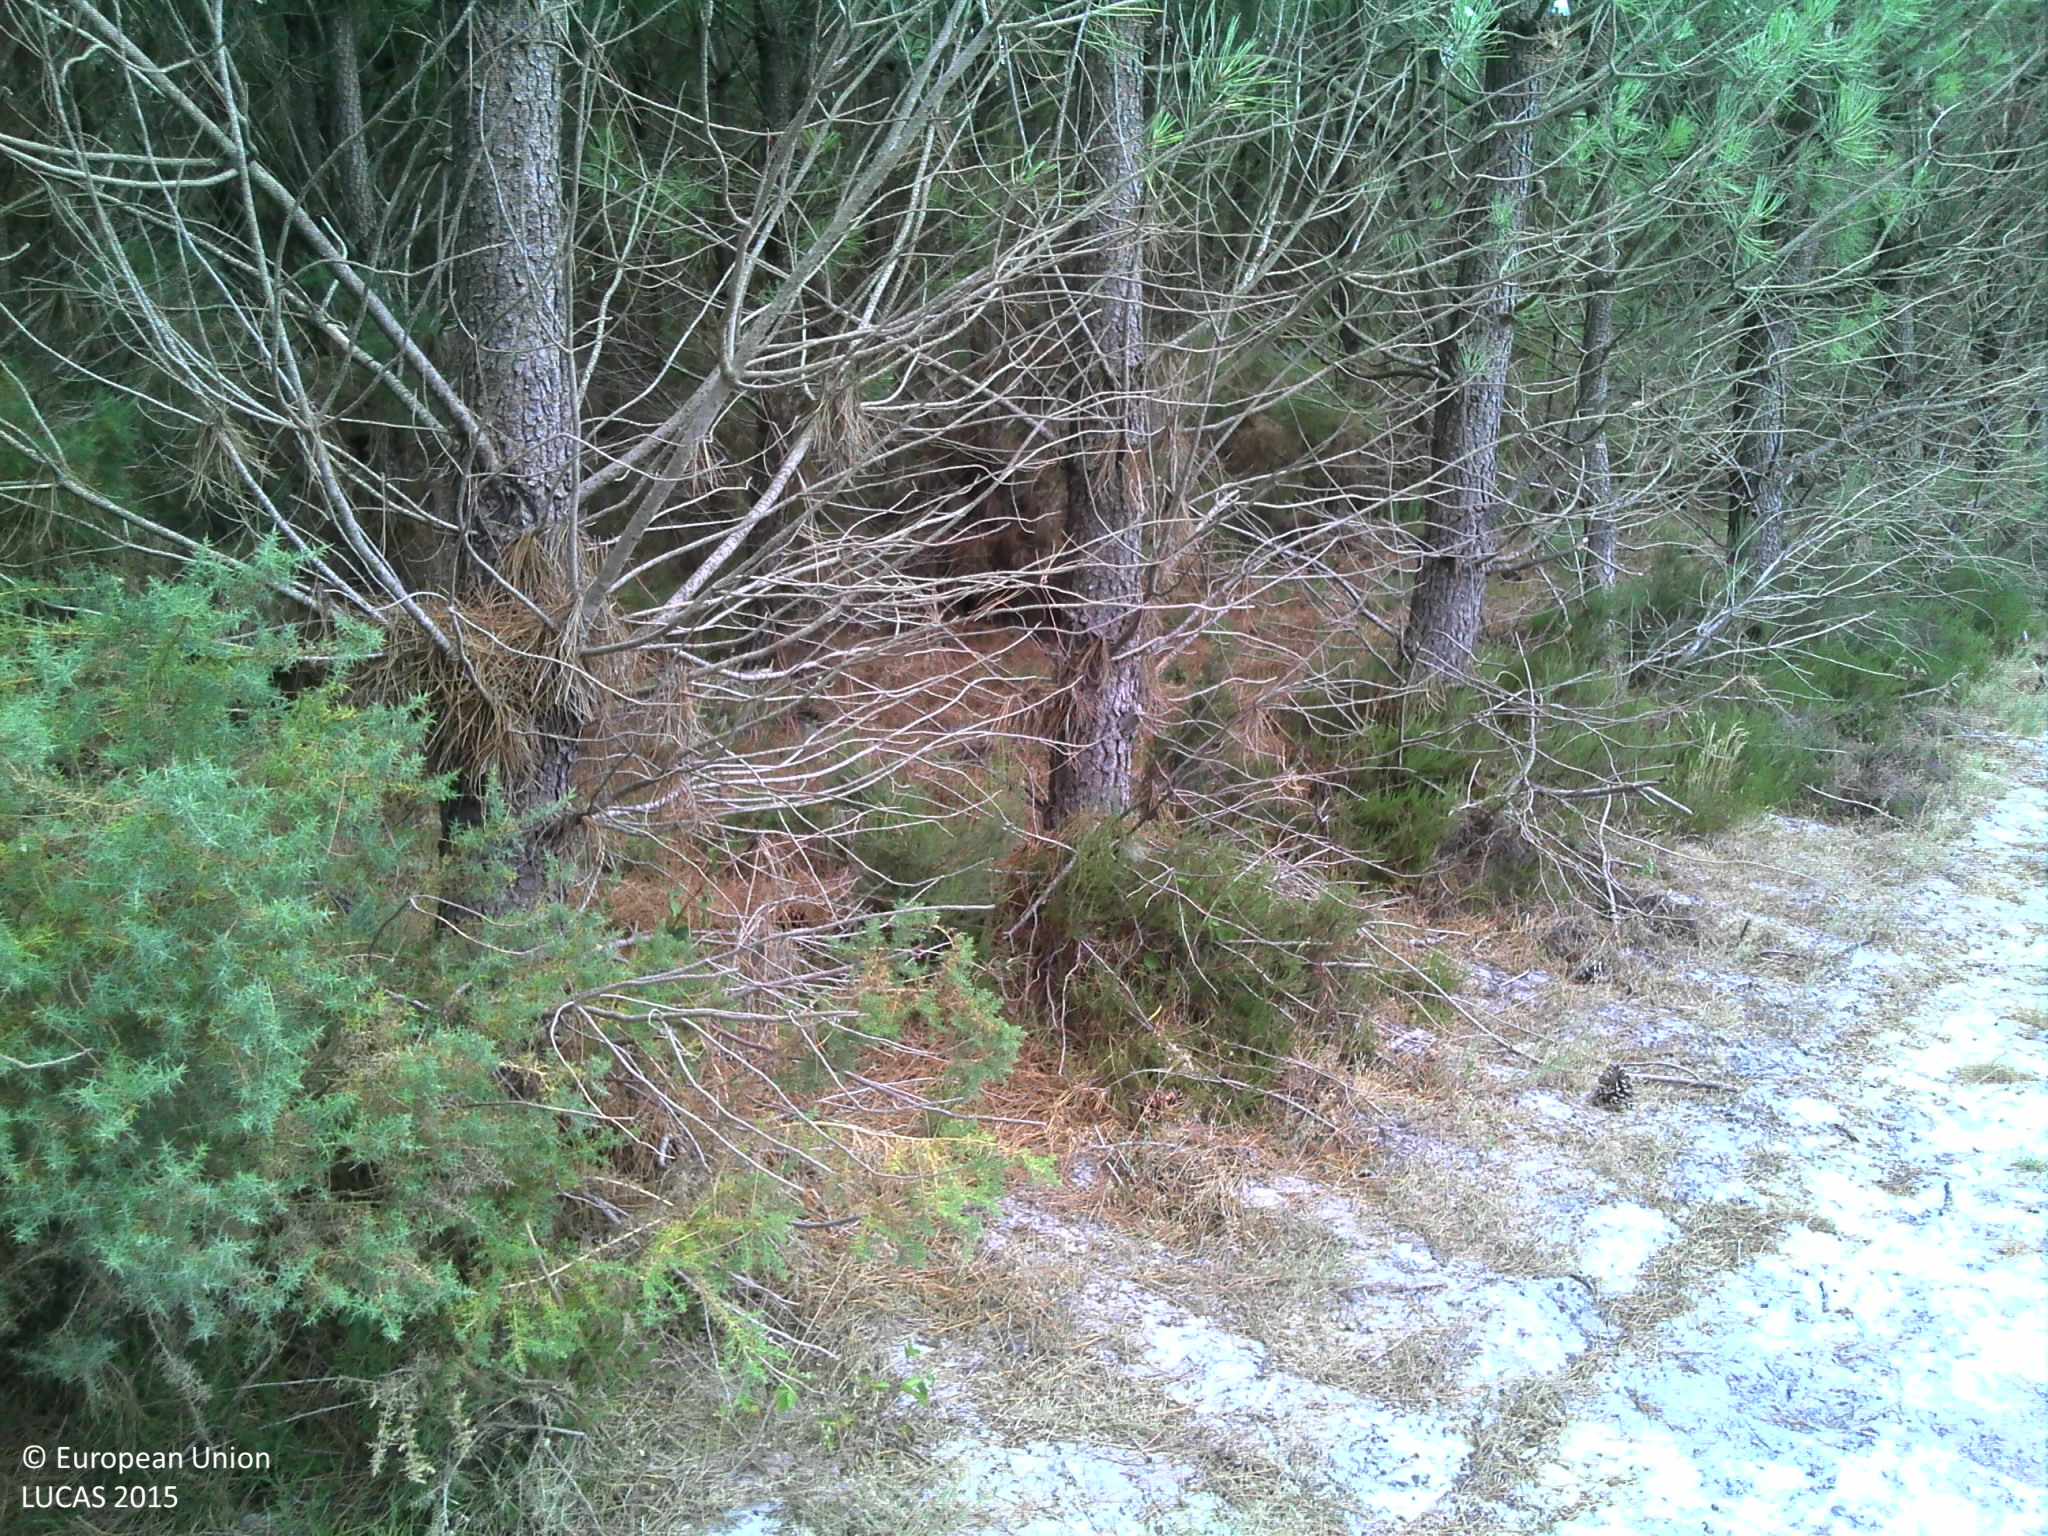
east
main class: Woodland
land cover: Pine dominated coniferous woodland
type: coniferous forest of the mediterranean region
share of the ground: > 75 %
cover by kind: coniferous forest trees 90 %, shrubs 5 %, herbaceous plants 5 %
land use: Forestry
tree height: > 5 m
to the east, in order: Pine dominated coniferous woodland; Tracks; Ditches and canals; Grass margins; Paved roads, cycling and walking lanes; Grass margins; Ditches and canals; Grass margins; Pine dominated coniferous woodland
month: July
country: FR
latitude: 44.2653
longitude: -0.9039
